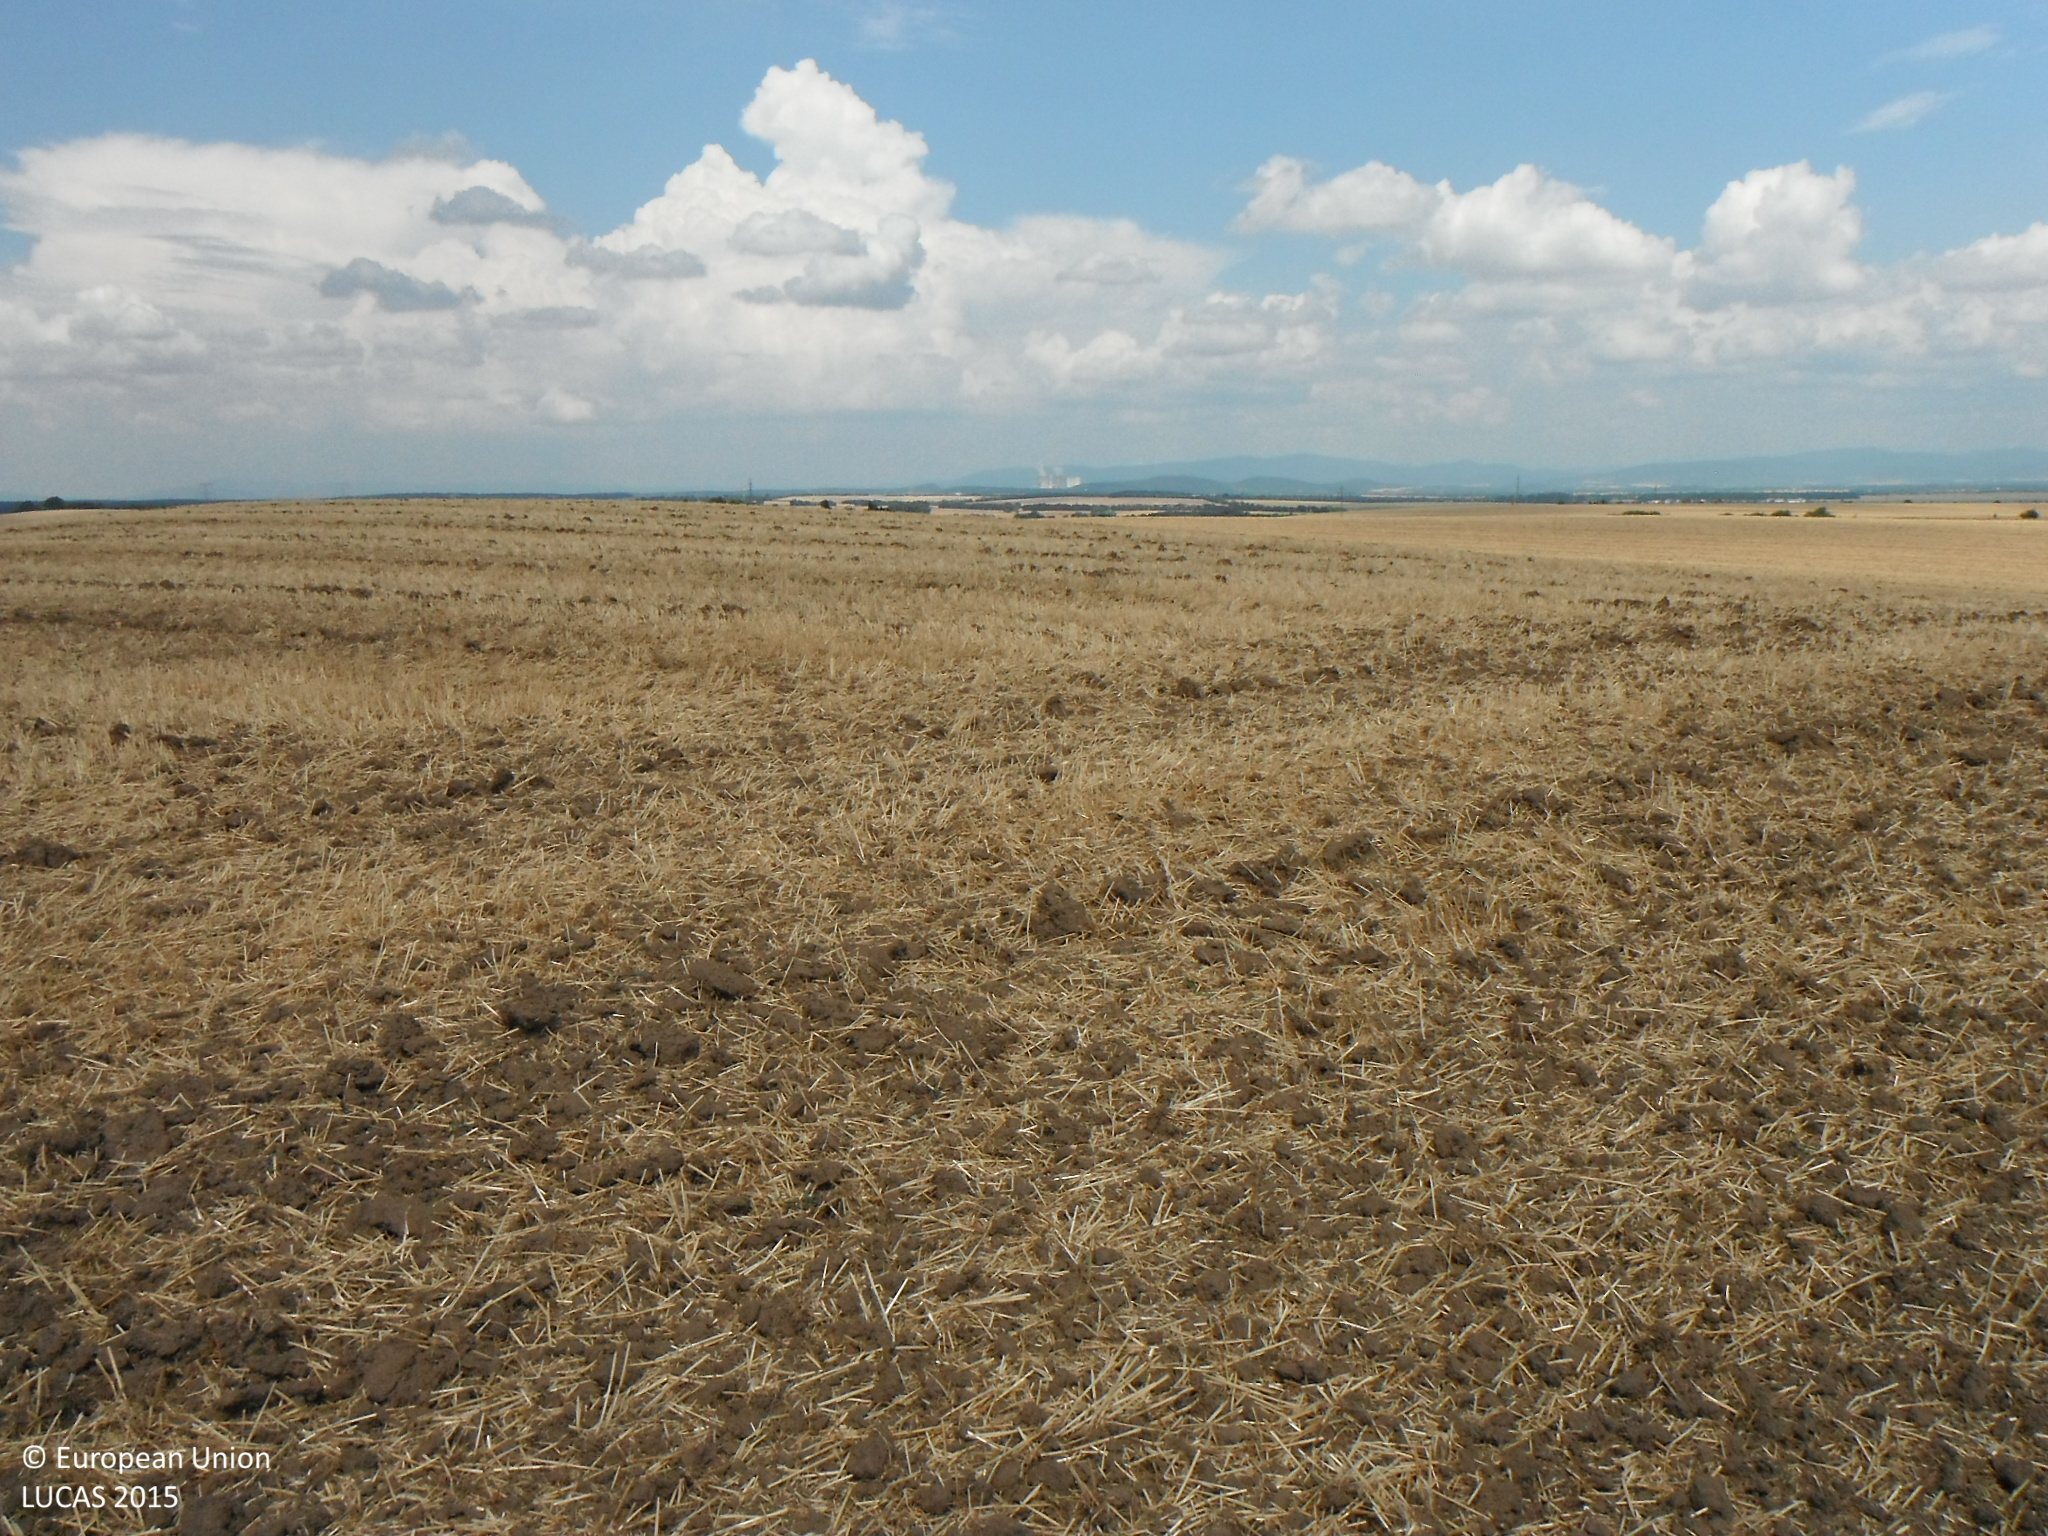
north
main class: Cropland
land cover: Common wheat
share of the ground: 10 - 25 %
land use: Agriculture (excluding fallow land and kitchen gardens)
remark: Harvested field
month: August
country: SK
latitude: 48.1346
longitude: 18.4408
